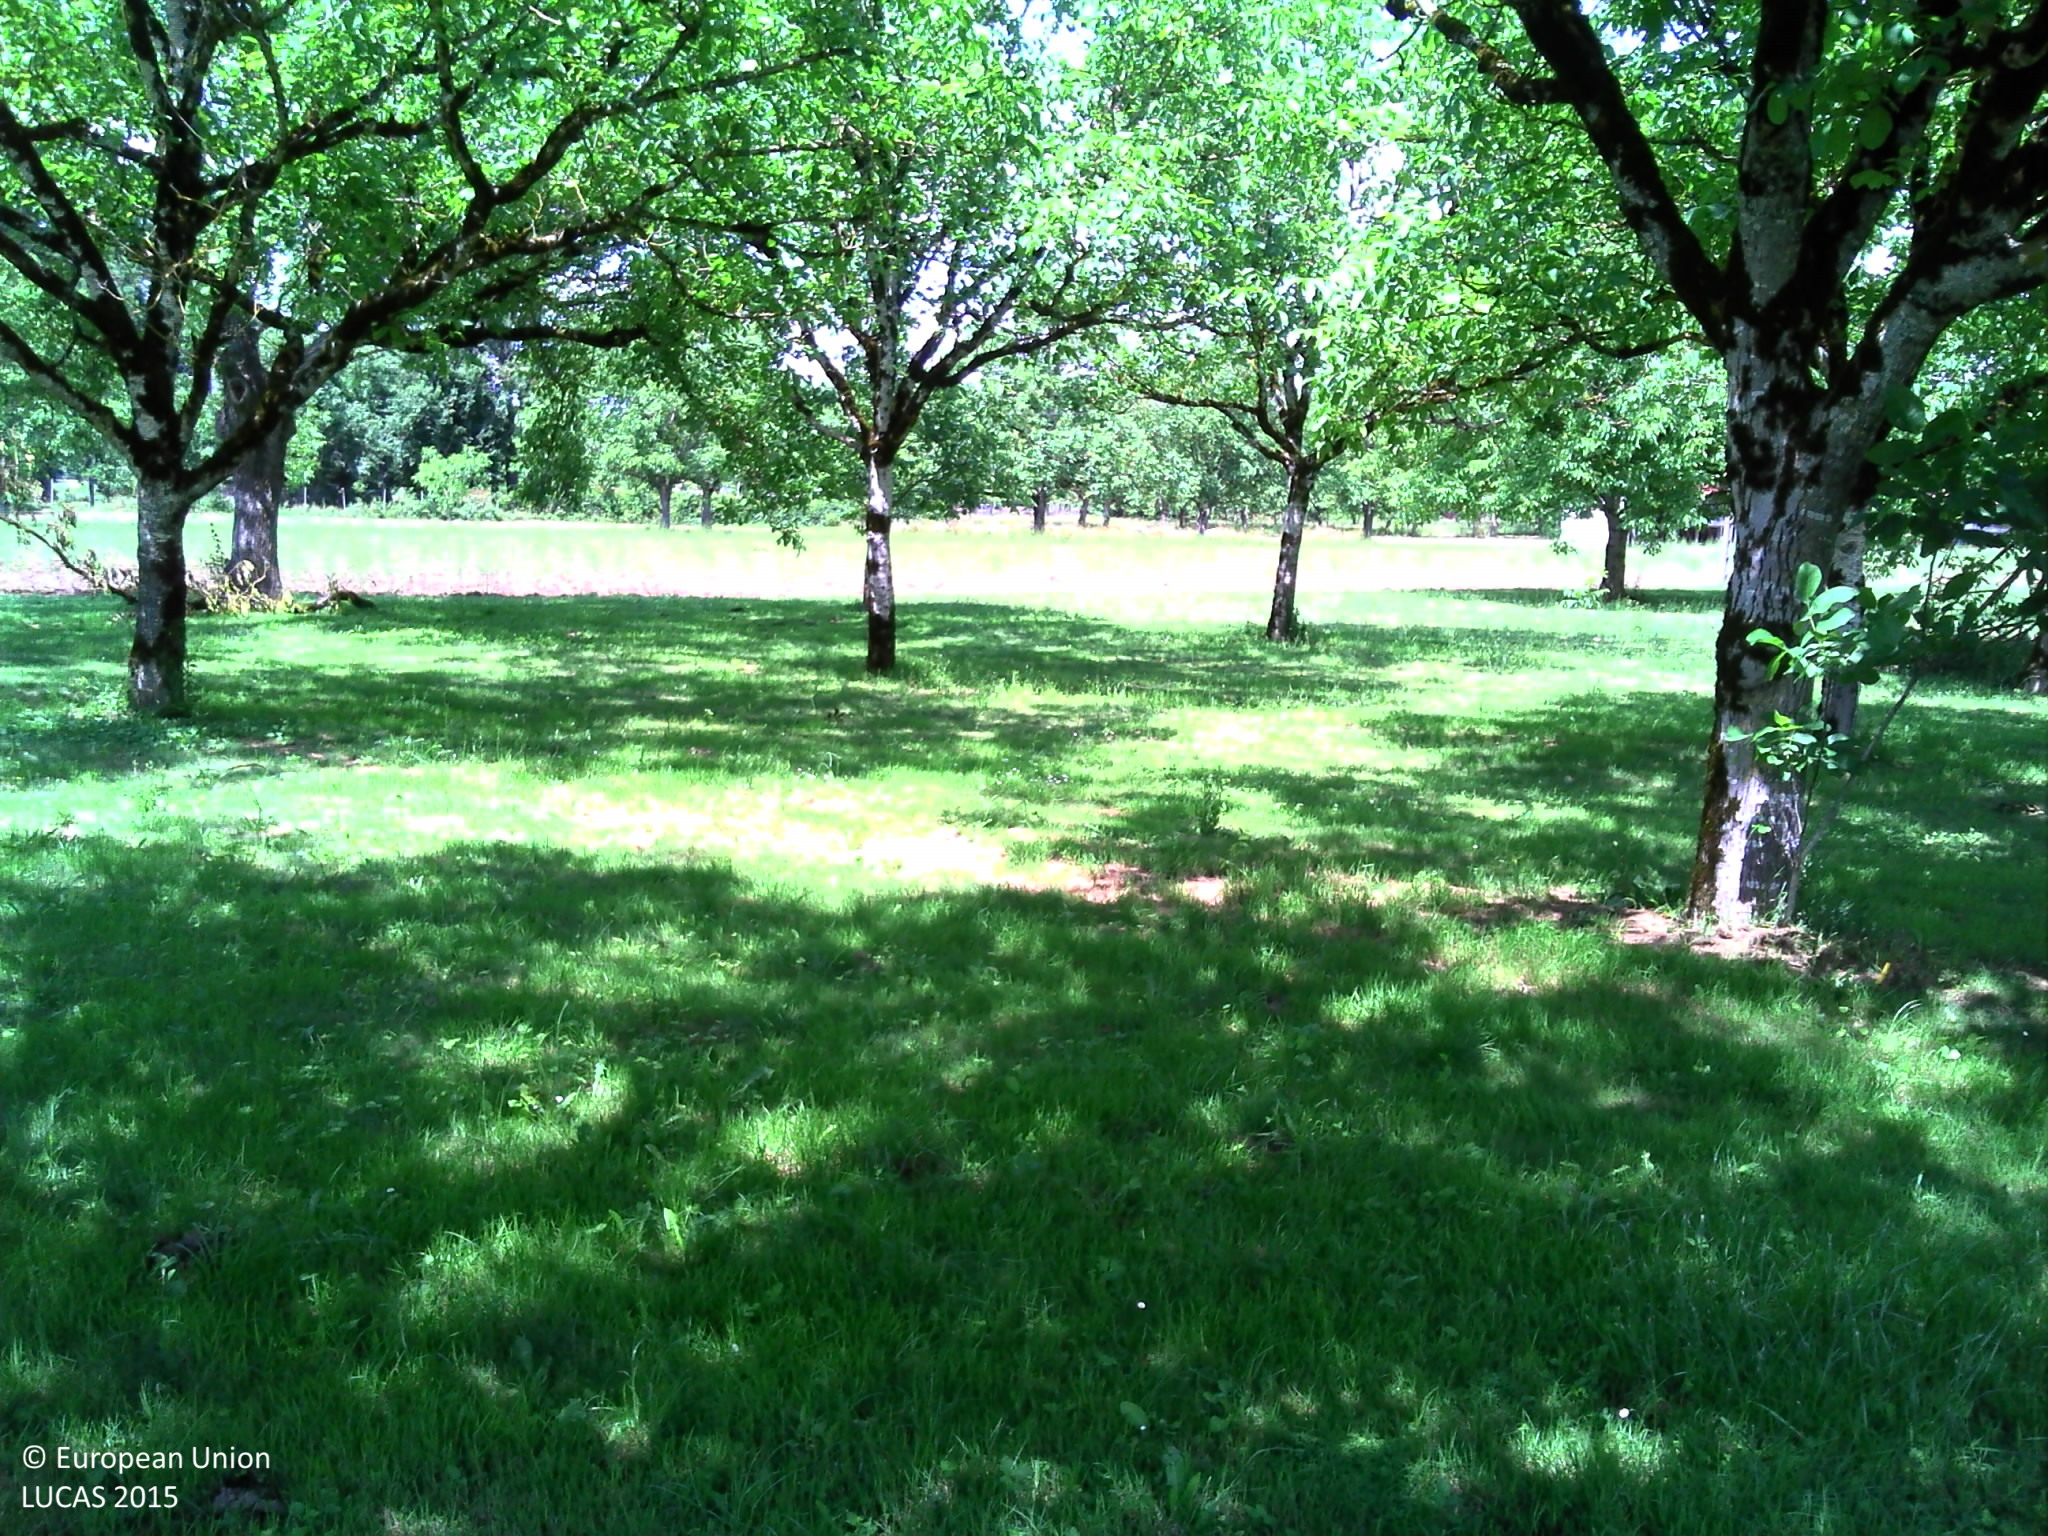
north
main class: Cropland
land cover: Nuts trees
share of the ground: 50 - 75 %
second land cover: Grassland without tree/shrub cover
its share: 10 - 25 %
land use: Agriculture (excluding fallow land and kitchen gardens)
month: June
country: FR
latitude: 44.9275
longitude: 1.7494
